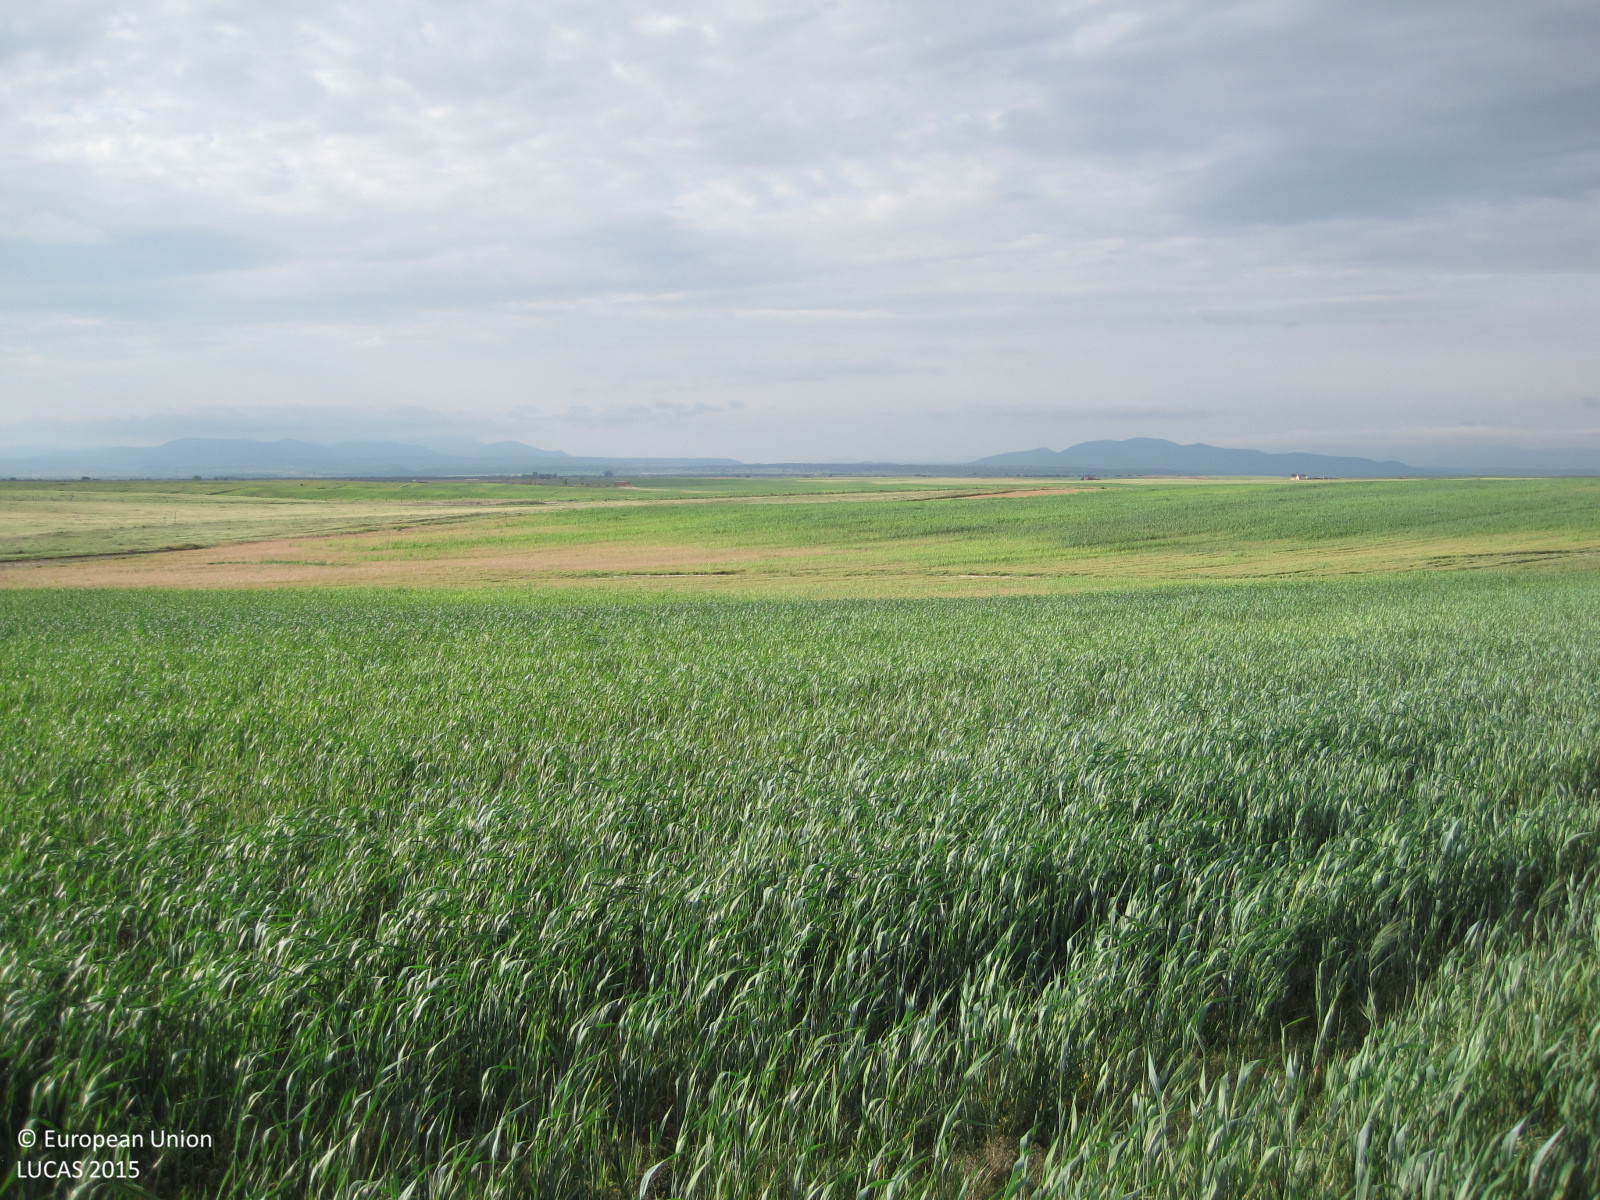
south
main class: Cropland
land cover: Barley
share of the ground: > 75 %
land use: Agriculture (excluding fallow land and kitchen gardens)
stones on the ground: 10 - 25 %
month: April
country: ES
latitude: 39.9094
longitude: -5.0353
